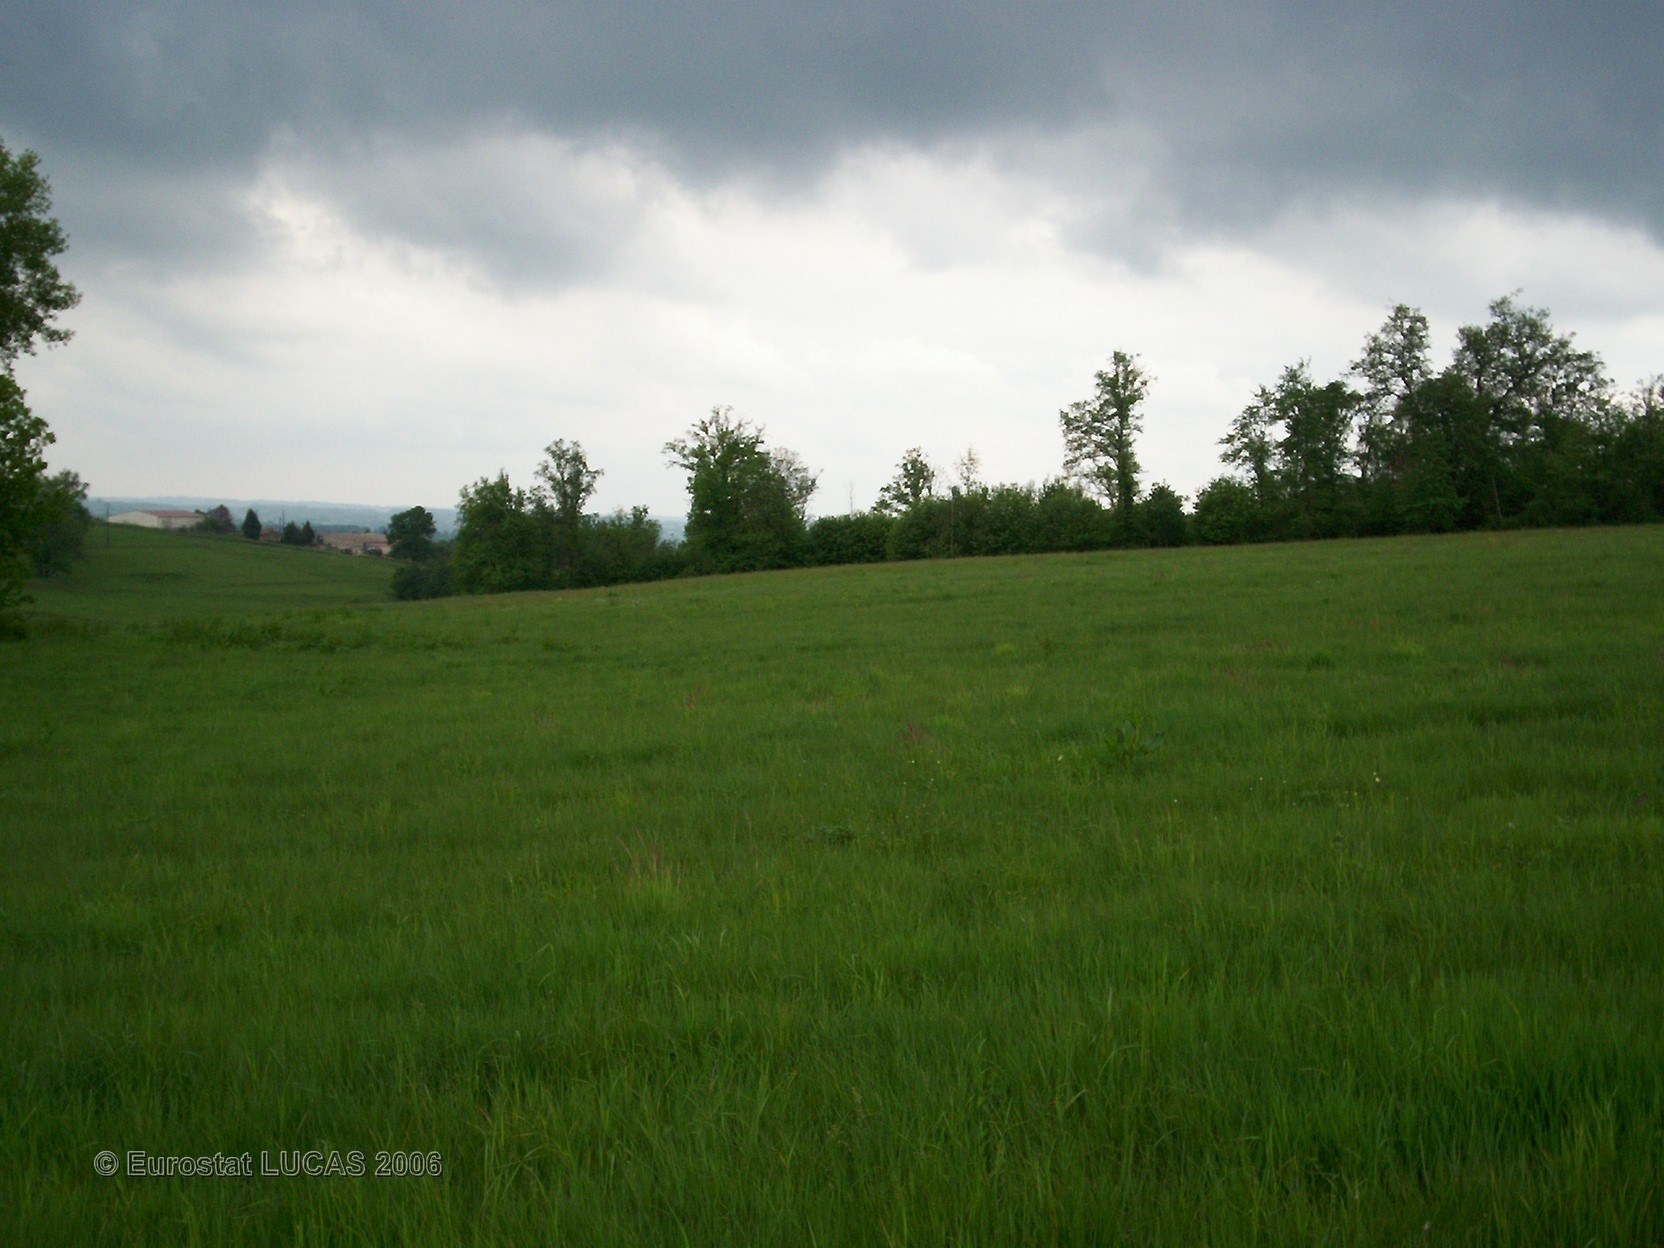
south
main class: Grassland
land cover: Grassland without tree/shrub cover
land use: Agriculture (excluding fallow land and kitchen gardens)
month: May
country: FR
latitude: 45.7317
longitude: 0.5412
